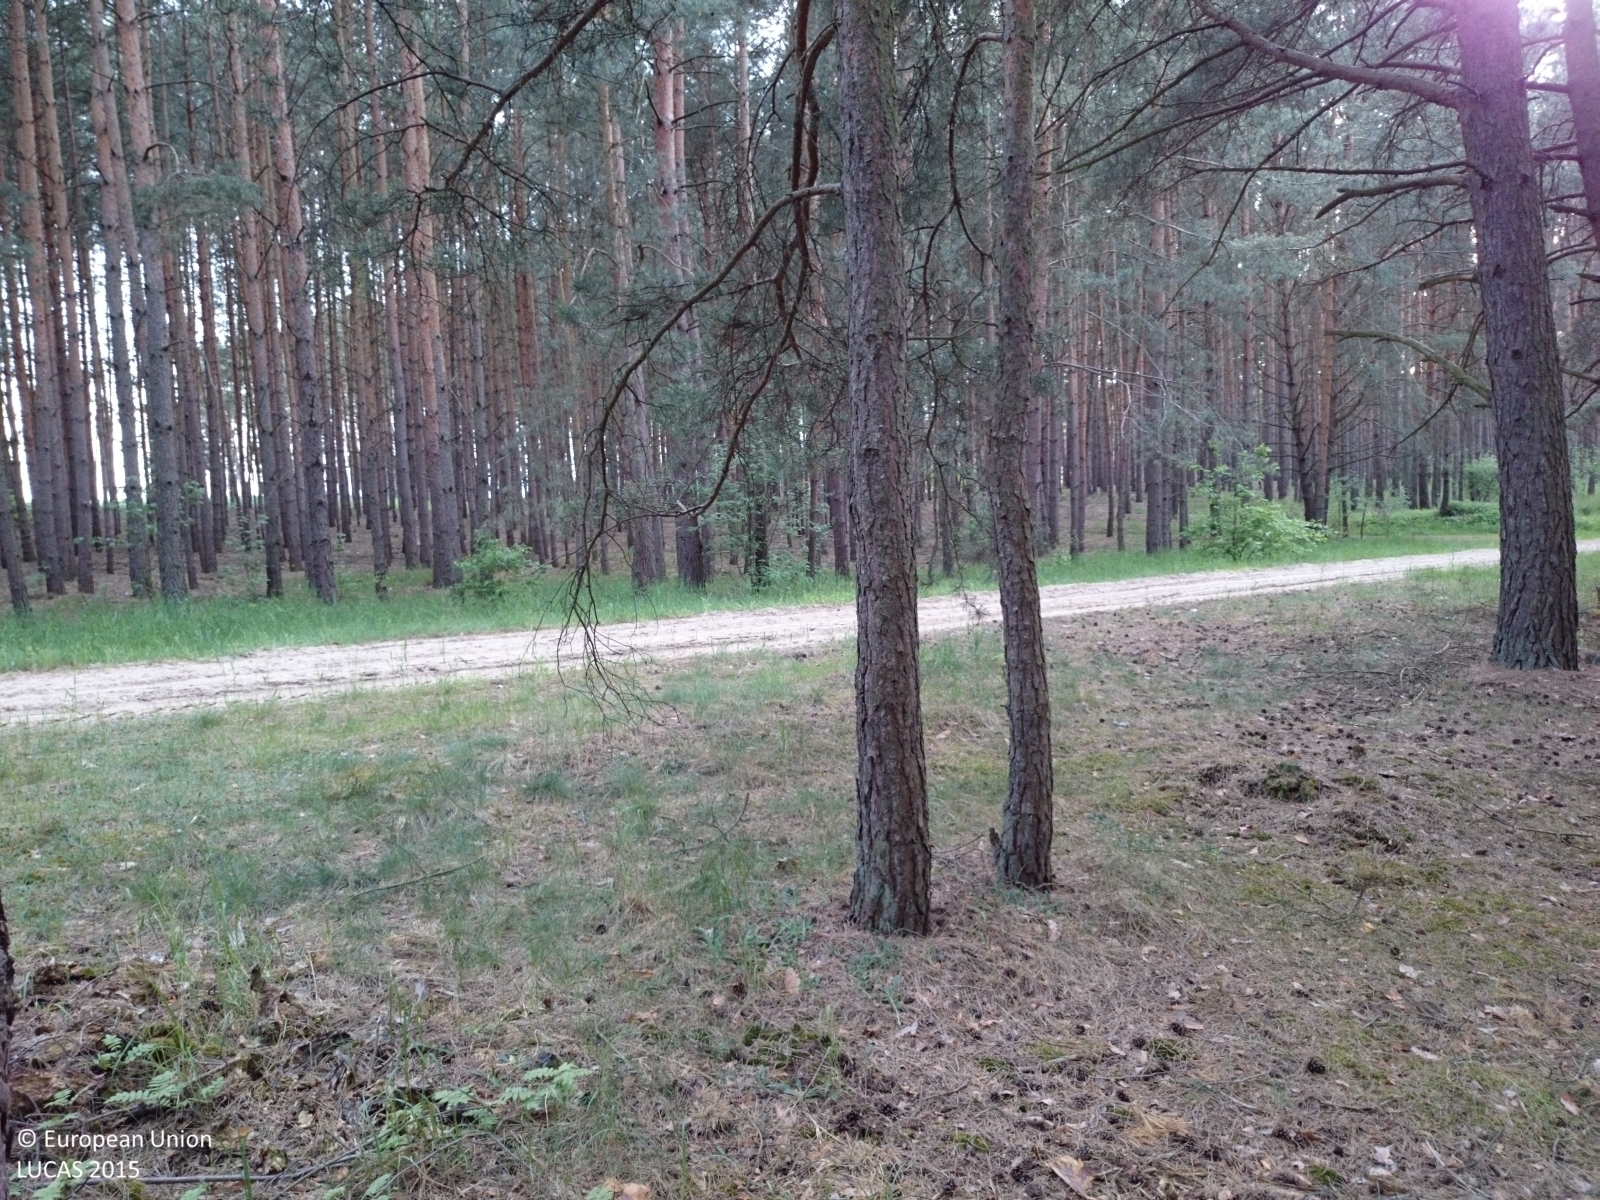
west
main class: Woodland
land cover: Pine dominated coniferous woodland
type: hemiboreal forest and nemoral coniferous forest and mixed broadleaved-coniferous forest
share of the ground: > 75 %
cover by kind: coniferous forest trees 100 %
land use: Forestry
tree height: > 5 m
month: May
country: PL
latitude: 52.6093
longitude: 16.2531
